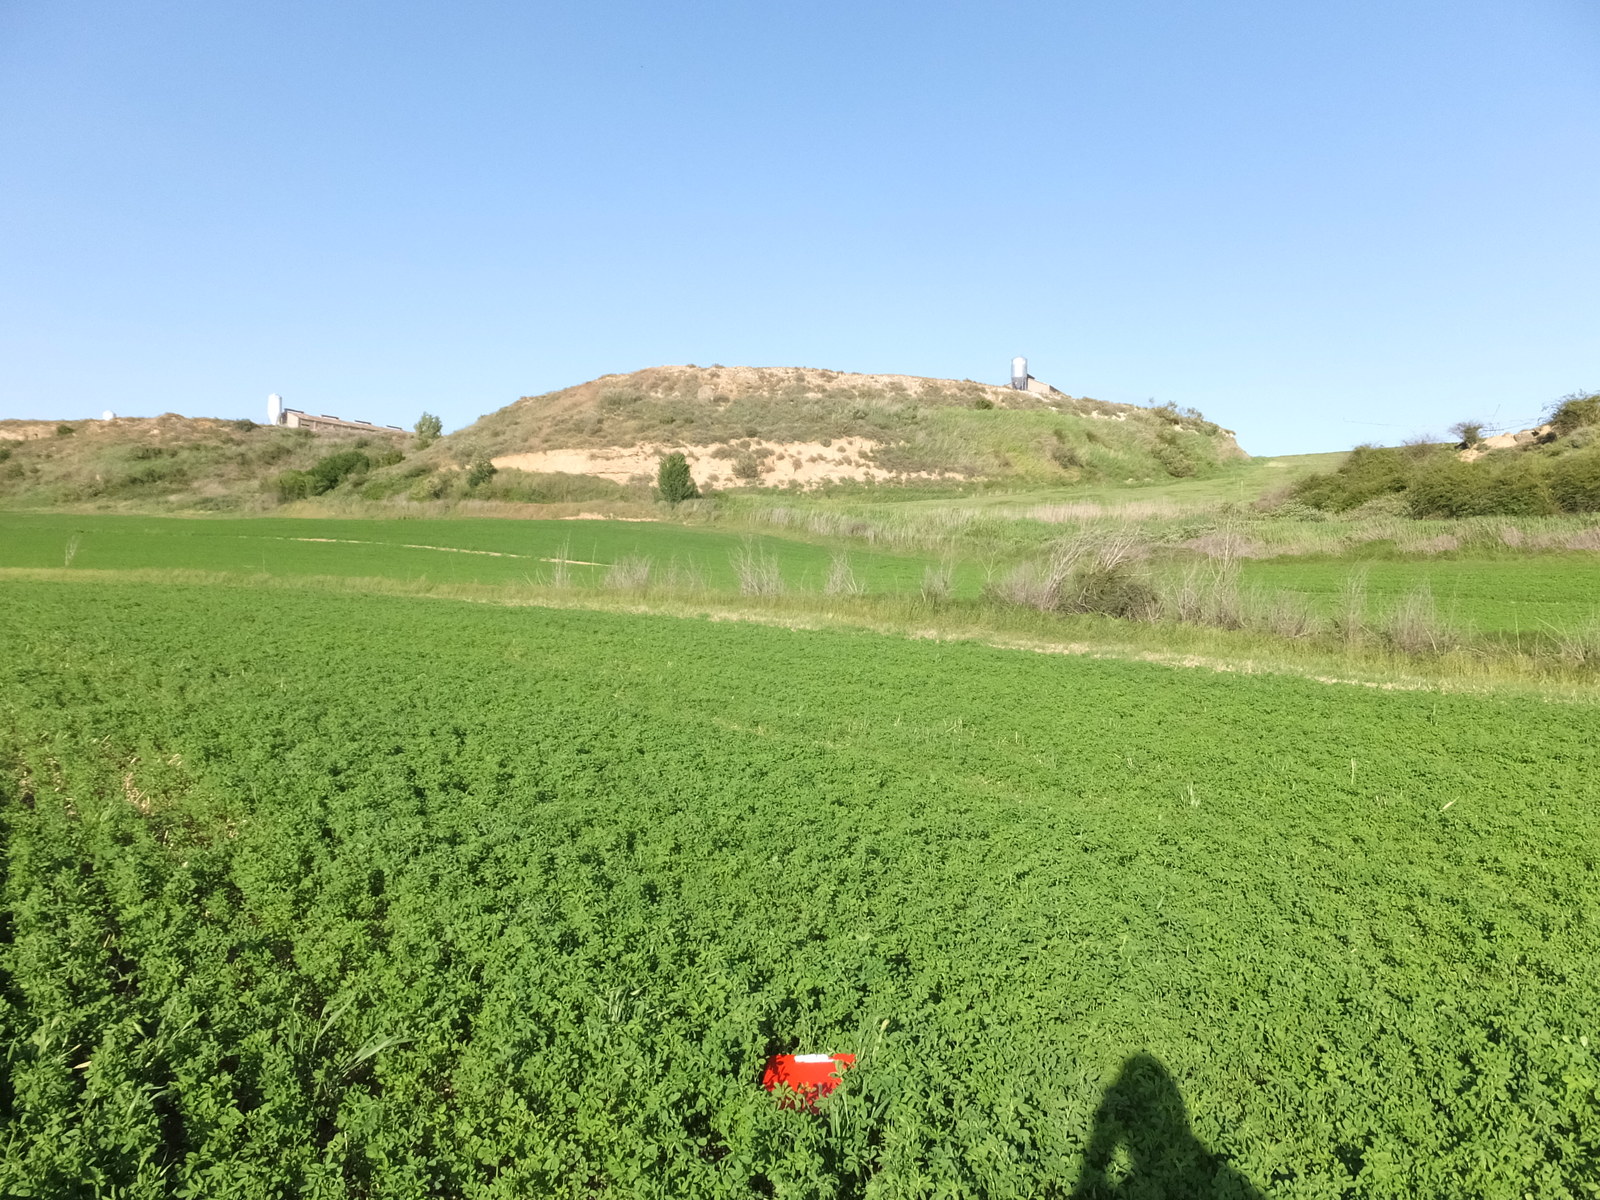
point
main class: Cropland
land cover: Lucerne
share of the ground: > 75 %
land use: Agriculture (excluding fallow land and kitchen gardens)
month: May
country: ES
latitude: 41.6353
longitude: 0.4190
